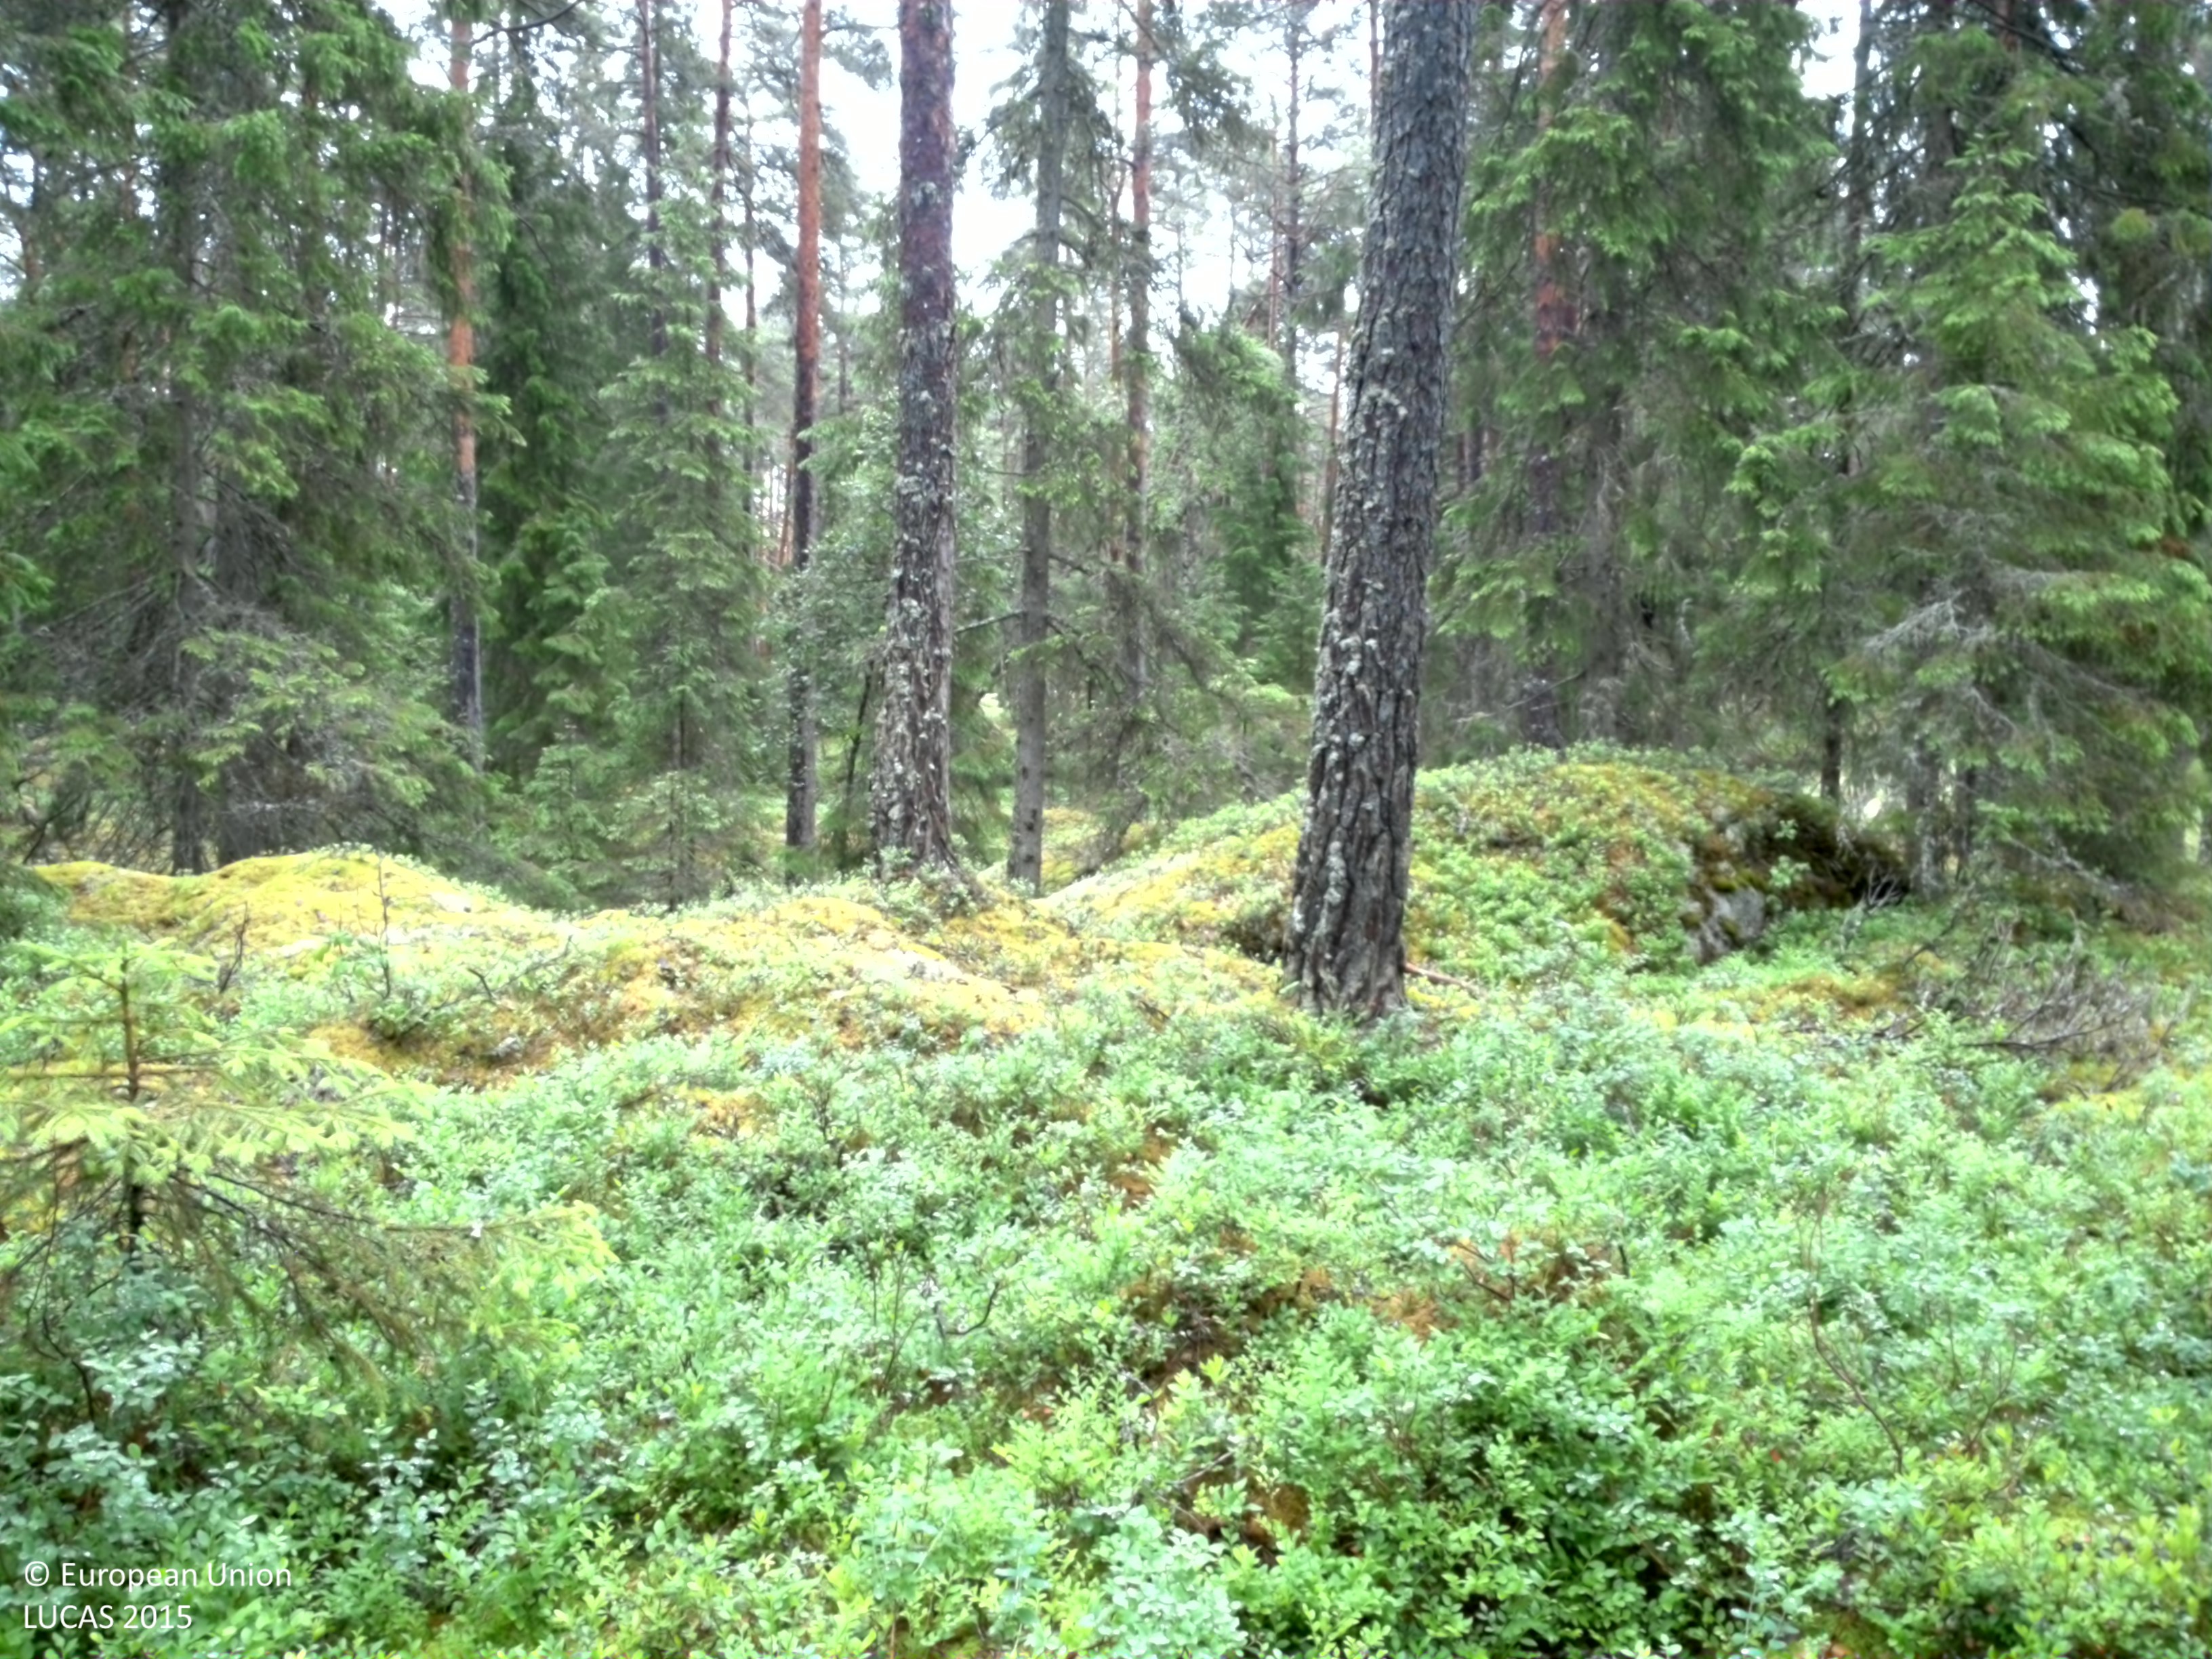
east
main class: Woodland
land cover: Pine dominated coniferous woodland
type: boreal forest
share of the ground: > 75 %
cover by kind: coniferous forest trees 80 %, broadleaved forest trees 10 %, lichens and mosses 10 %
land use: Amenities, museums, leisure
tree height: > 5 m
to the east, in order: Pine dominated coniferous woodland; Other coniferous woodland; Pine dominated coniferous woodland; Other mixed woodland; Pine dominated coniferous woodland
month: June
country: SE
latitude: 59.8366
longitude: 17.1476
